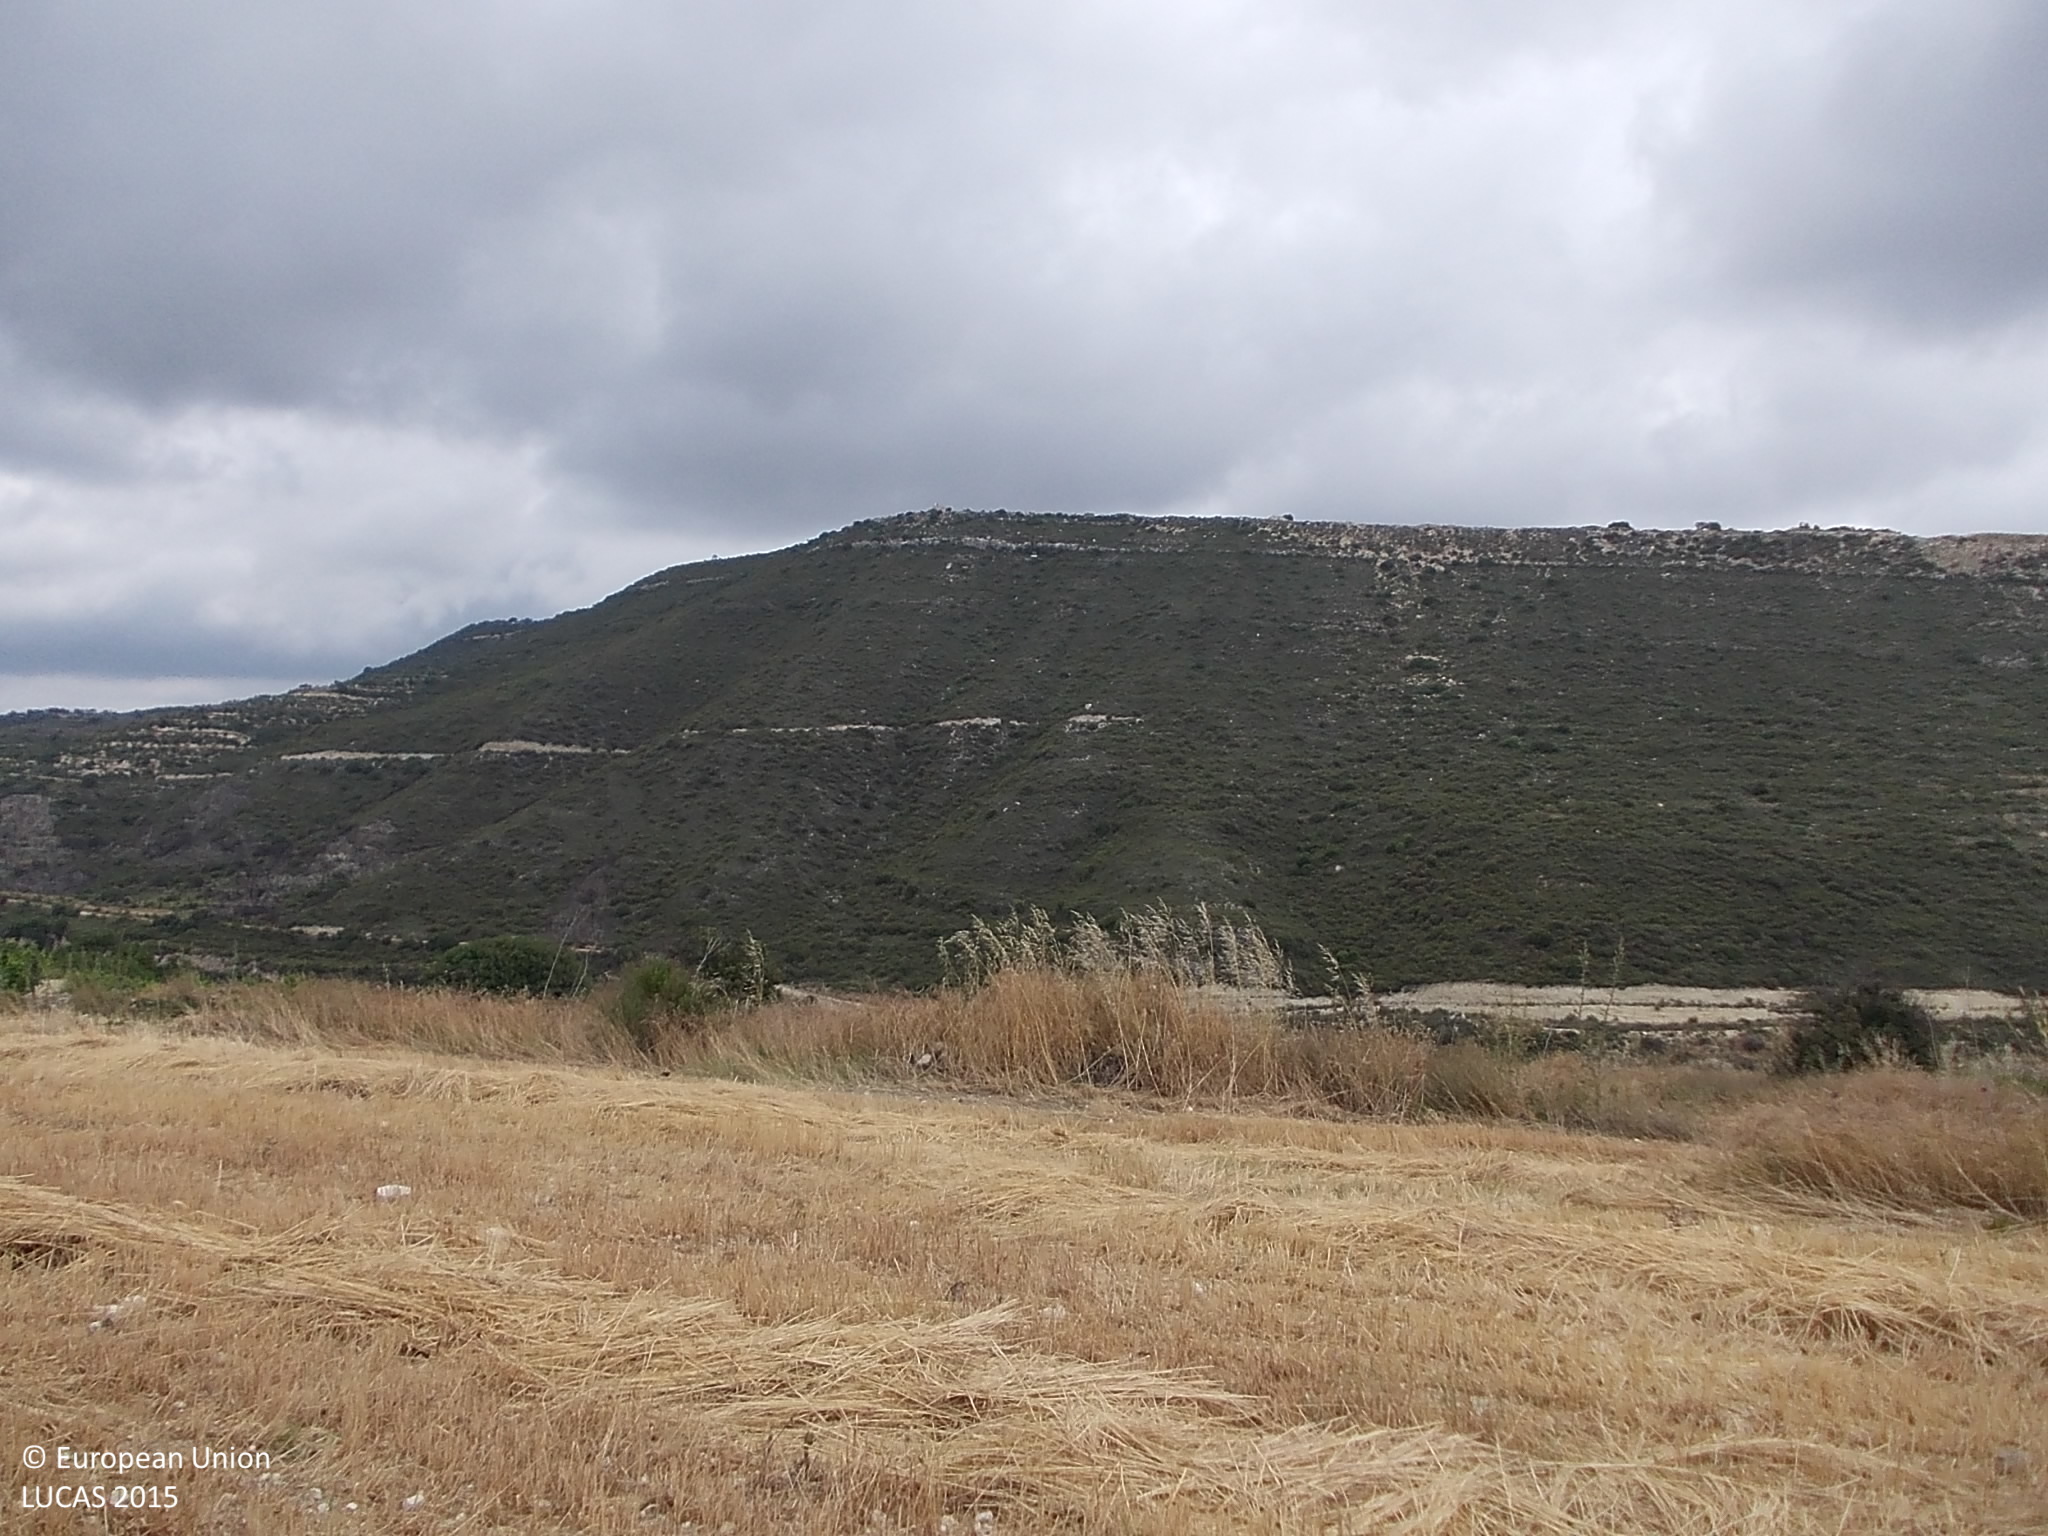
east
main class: Cropland
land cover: Oats
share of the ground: > 75 %
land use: Agriculture (excluding fallow land and kitchen gardens)
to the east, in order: Oats; Dry stone walls; Other bare soil; Dry stone walls; Vineyards; Shrubland without tree cover; Vineyards; Shrubland without tree cover; Dry stone walls; Spontaneously vegetated surfaces; Dry stone walls; Spontaneously vegetated surfaces; Dry stone walls; Spontaneously vegetated surfaces; Dry stone walls; Spontaneously vegetated surfaces; Dry stone walls; Shrubland without tree cover; Paved roads, cycling and walking lanes; Single bushes/trees; Shrubland without tree cover; Spontaneously vegetated surfaces
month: May
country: CY
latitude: 34.7678
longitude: 32.8083
